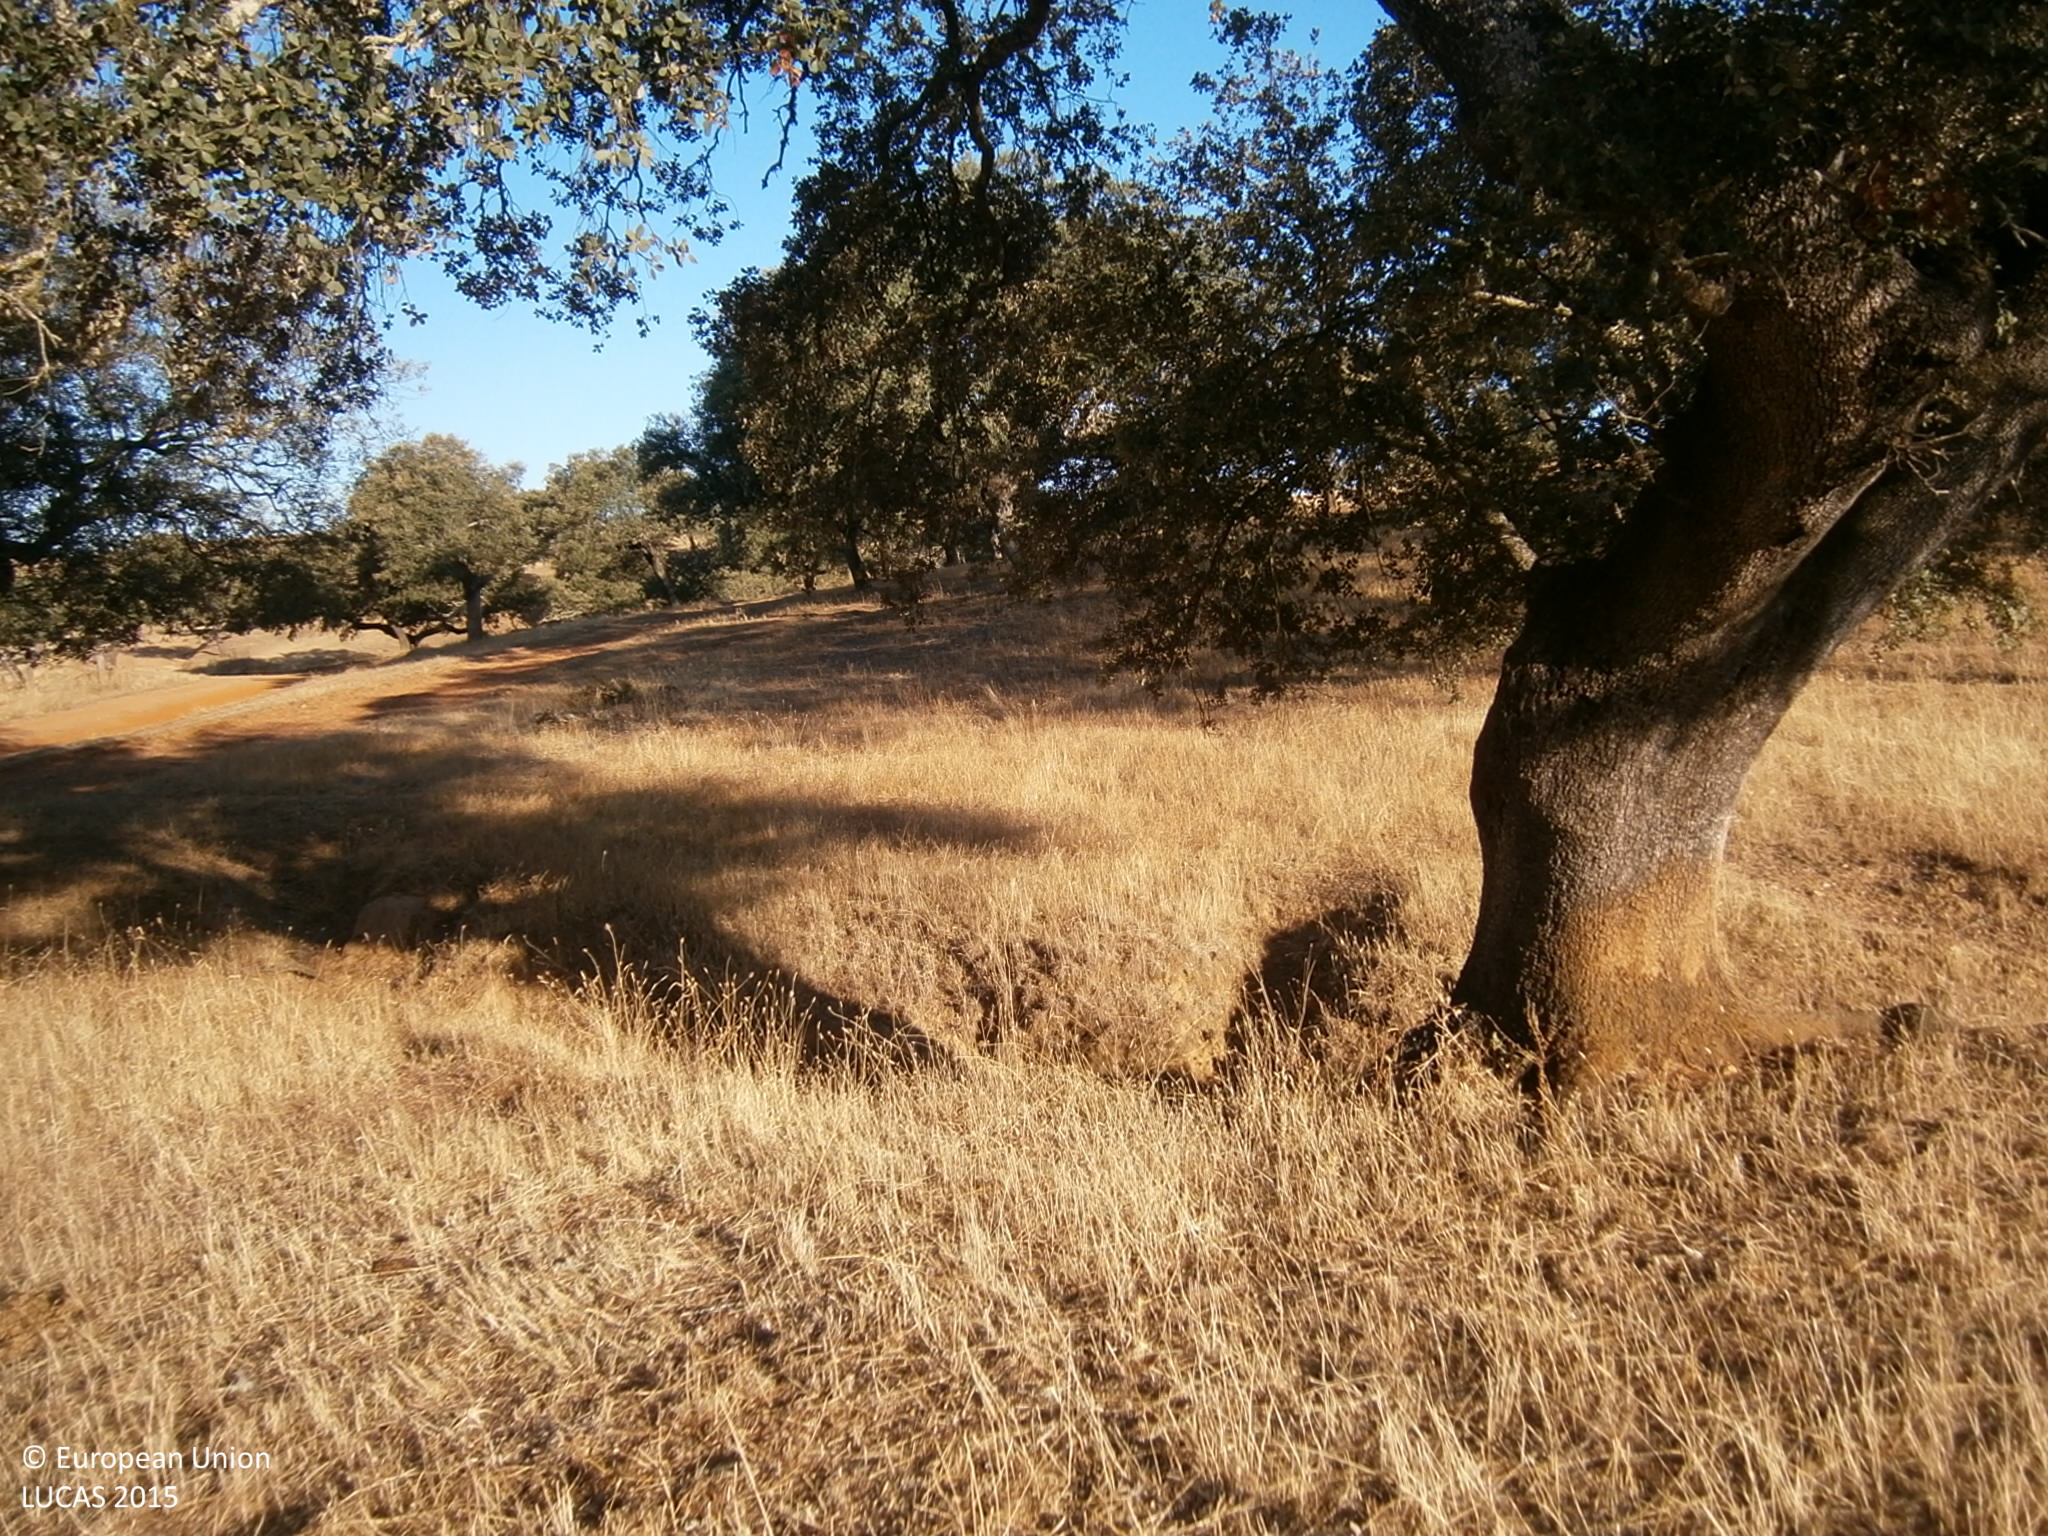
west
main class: Woodland
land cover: Broadleaved woodland
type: broadleaved evergreen forest
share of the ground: 50 - 75 %
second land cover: Spontaneously vegetated surfaces
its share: > 75 %
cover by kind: broadleaved forest trees 65 %, herbaceous plants 35 %
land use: Forestry
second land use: Agriculture (excluding fallow land and kitchen gardens)
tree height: > 5 m
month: July
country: ES
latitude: 38.6701
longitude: -7.2549
